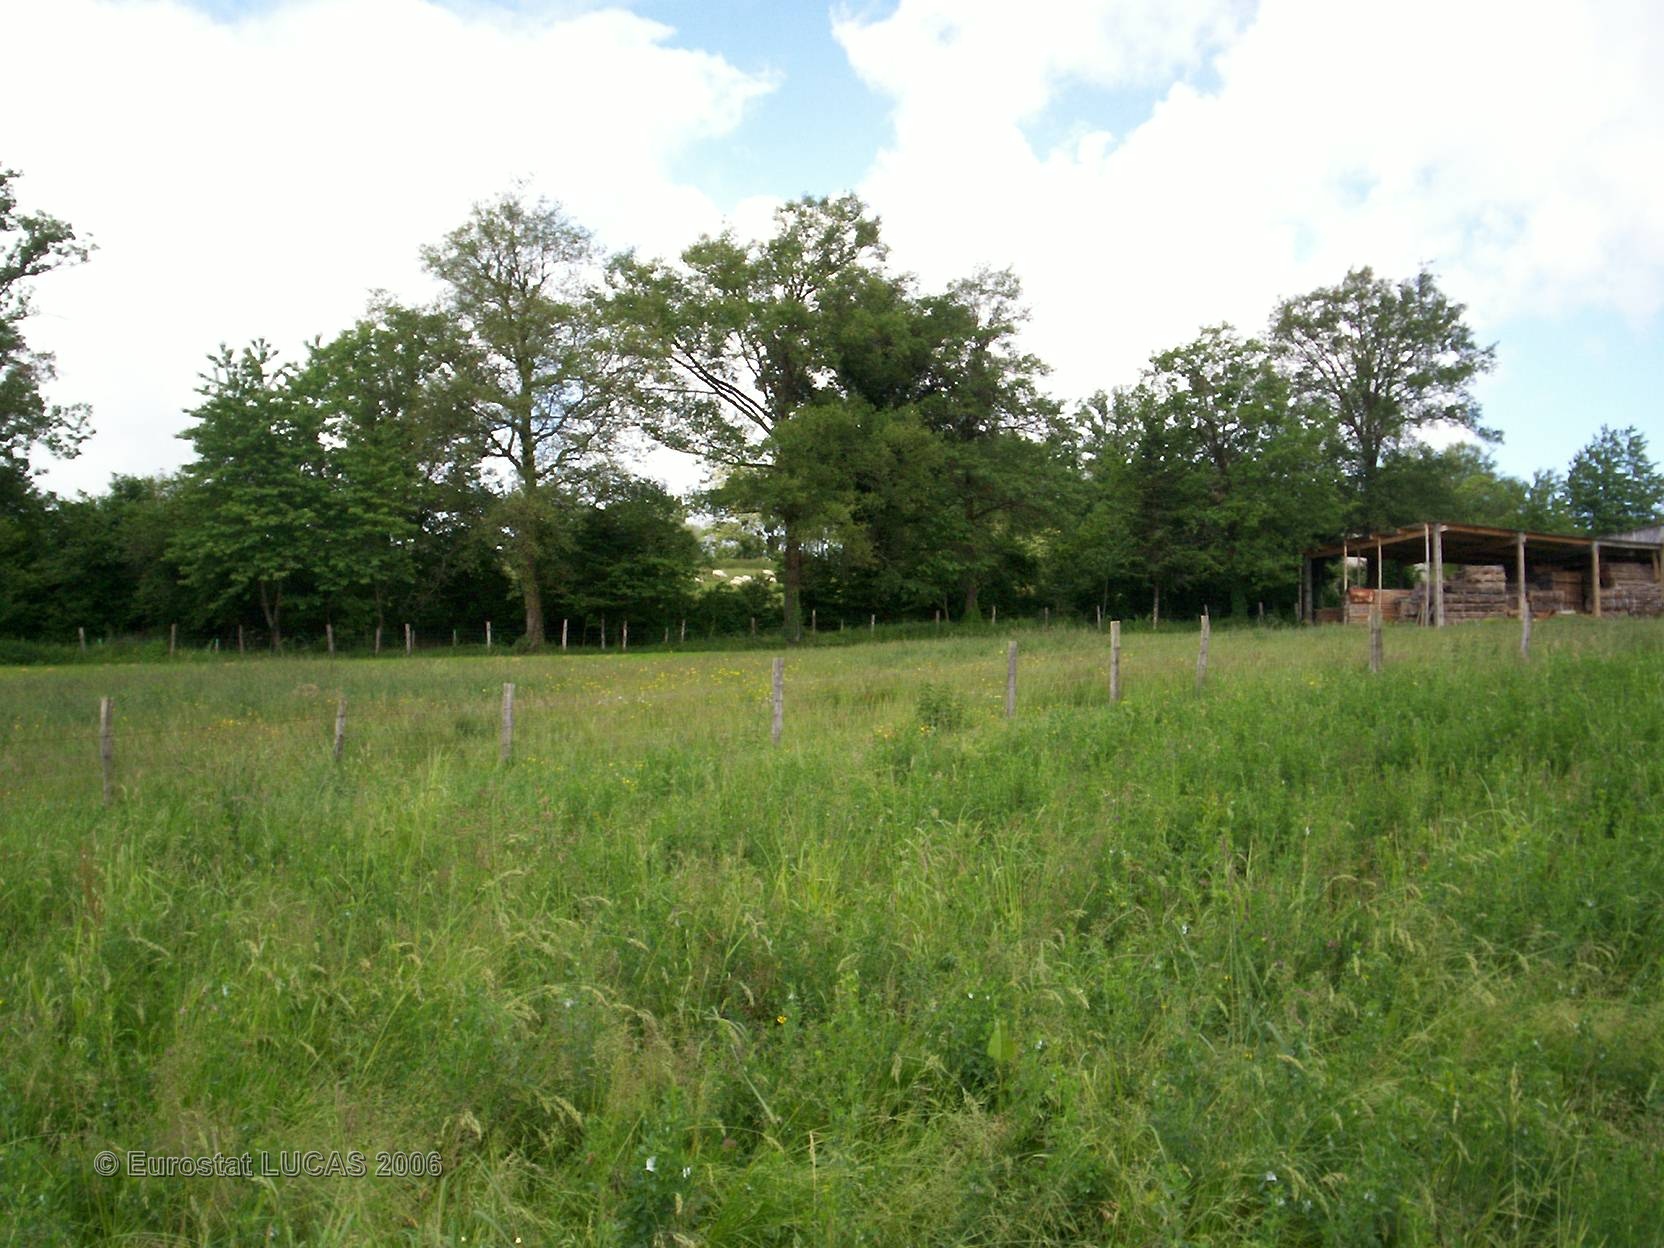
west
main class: Cropland
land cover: Lucerne
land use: Agriculture (excluding fallow land and kitchen gardens)
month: May
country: FR
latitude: 46.0690
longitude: 0.6642
